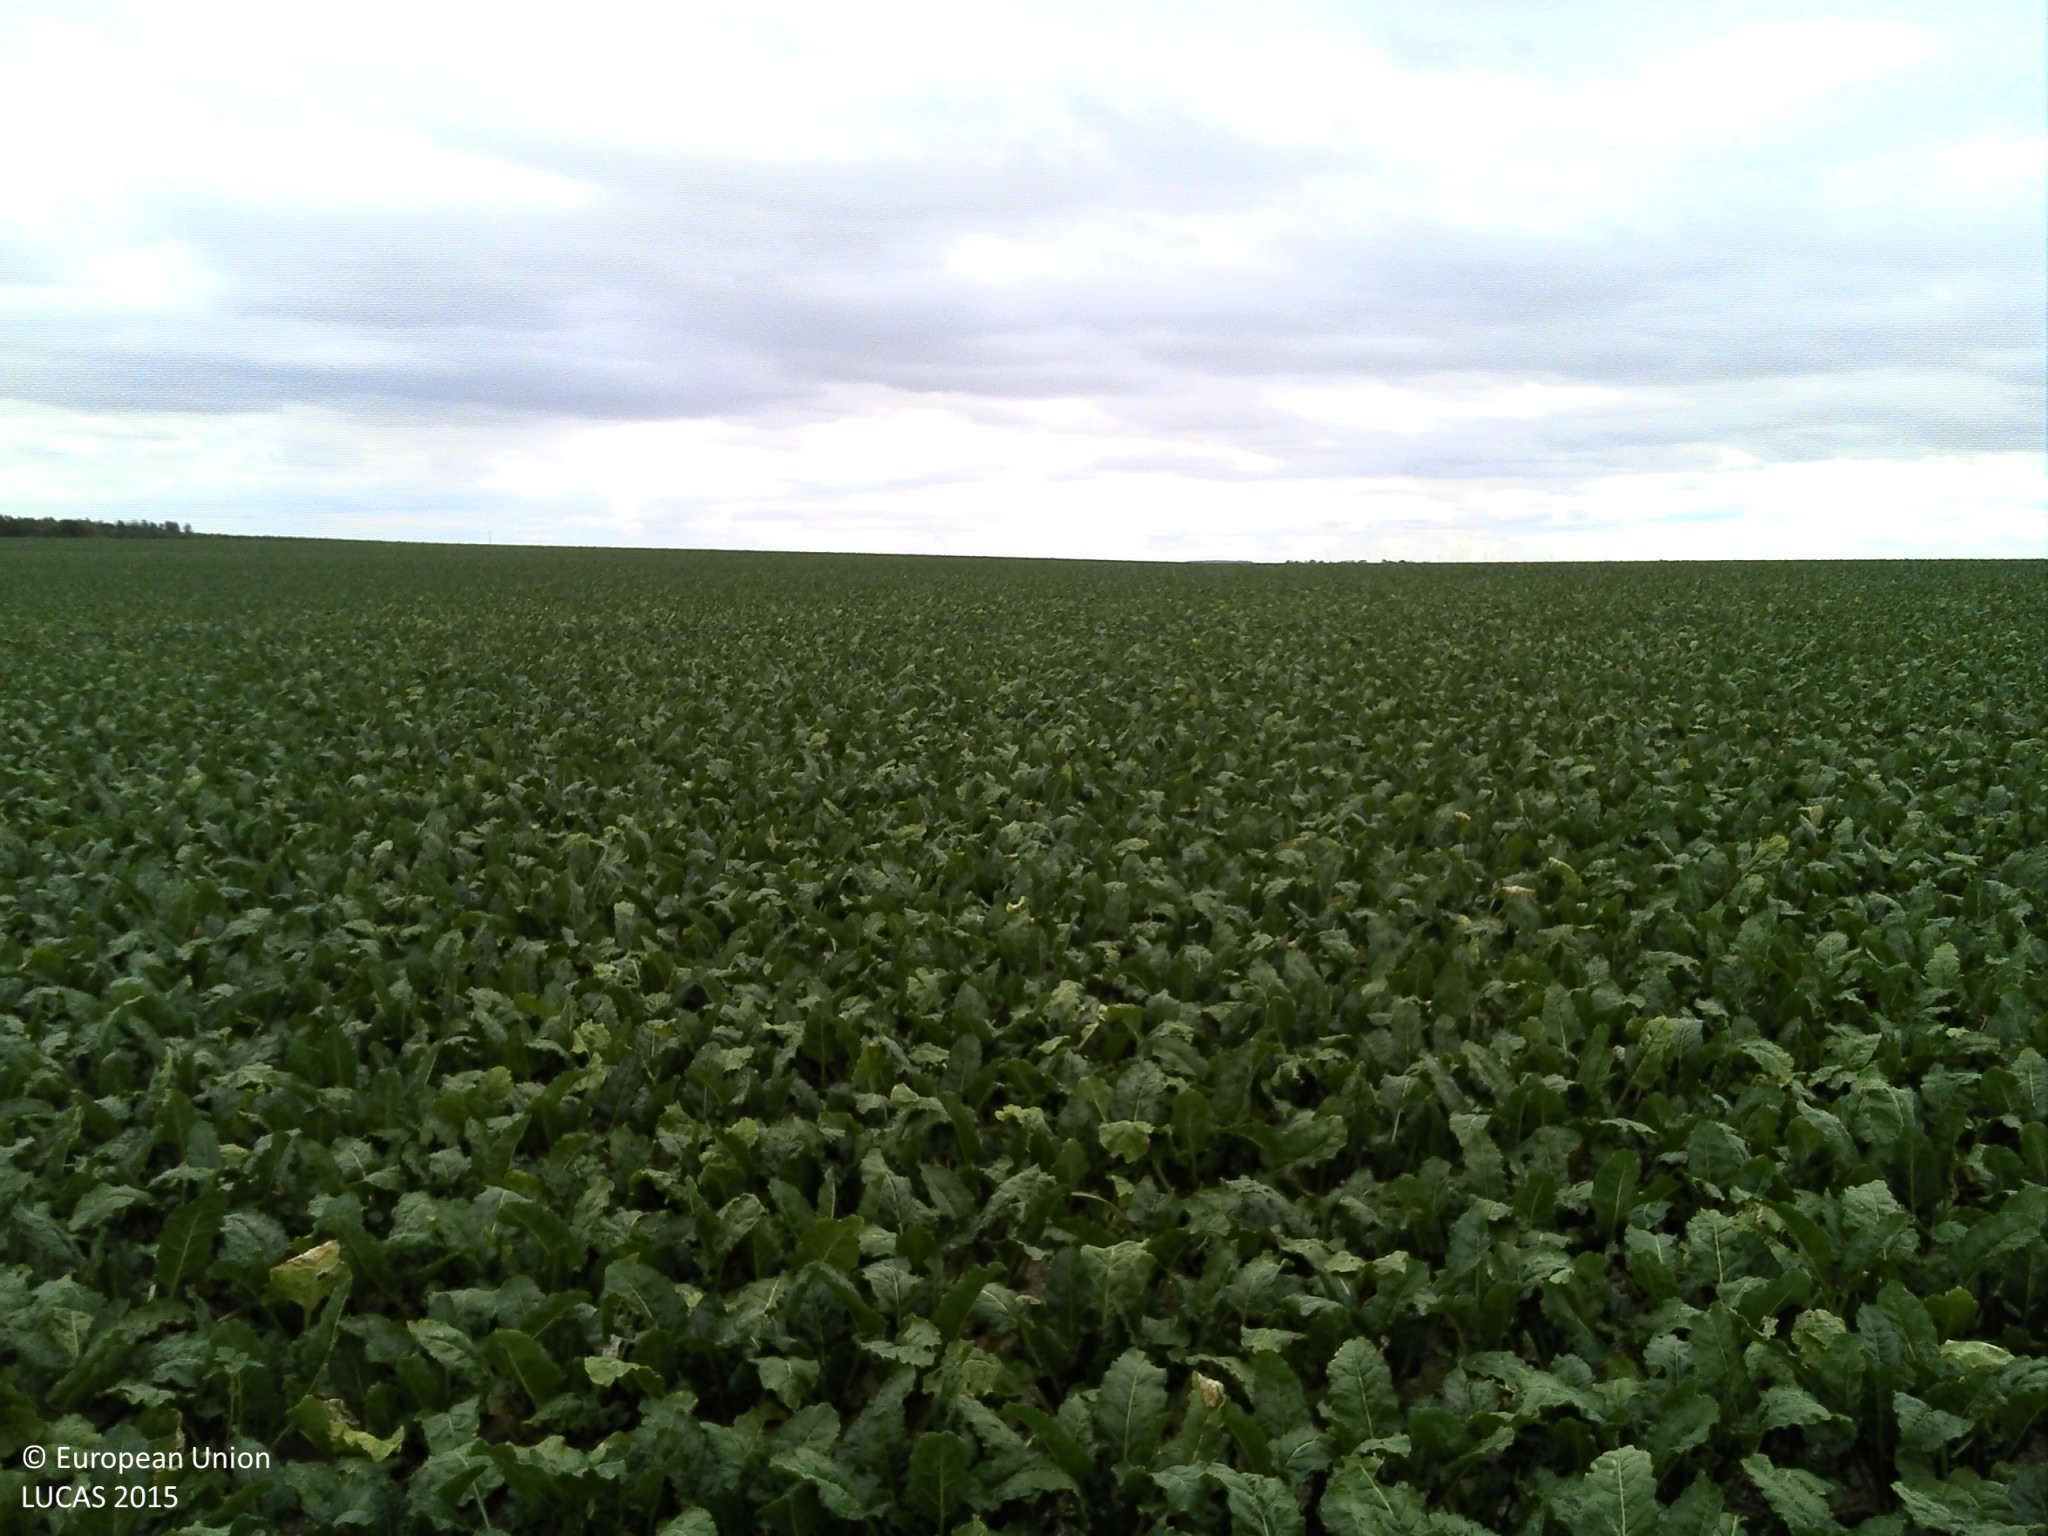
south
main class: Cropland
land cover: Sugar beet
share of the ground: > 75 %
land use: Agriculture (excluding fallow land and kitchen gardens)
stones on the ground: < 10 %
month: August
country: FR
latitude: 48.5019
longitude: 4.1630
